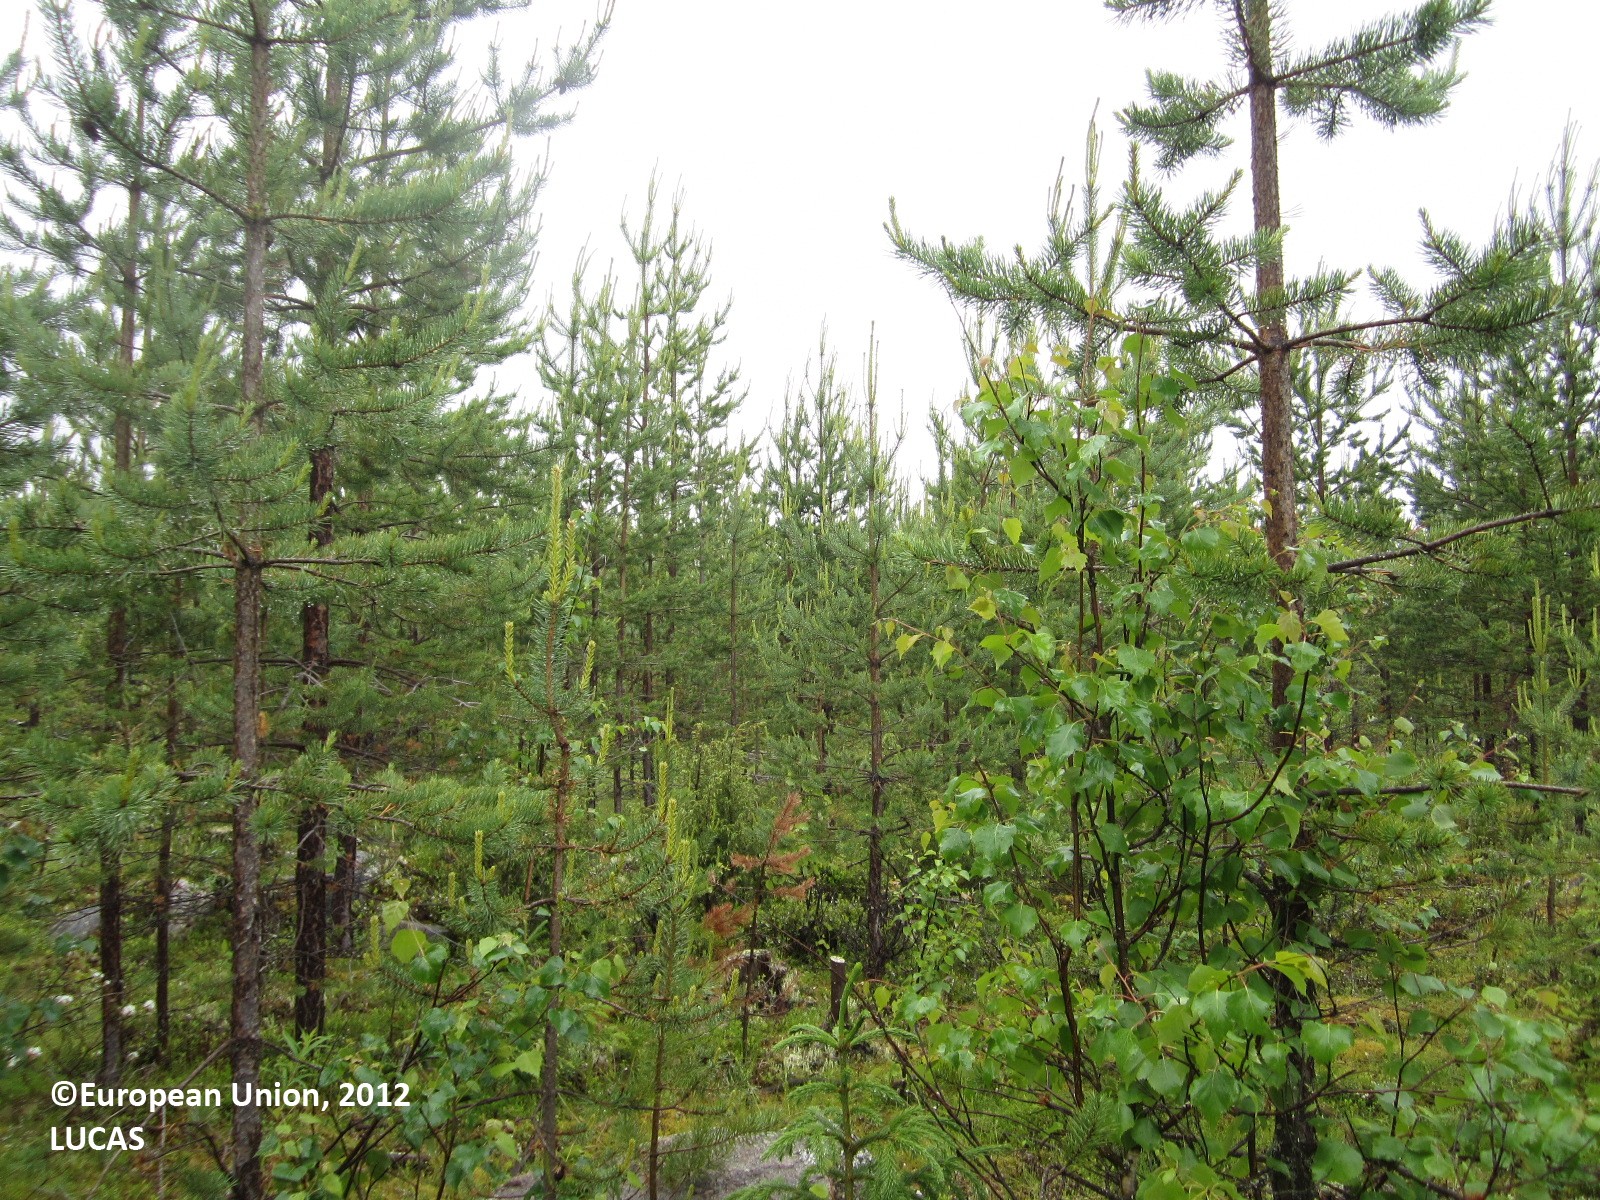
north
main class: Woodland
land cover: Pine dominated coniferous woodland
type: boreal forest
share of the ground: 50 - 75 %
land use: Forestry
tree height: < 5 m
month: June
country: FI
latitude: 64.5432
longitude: 29.8916
